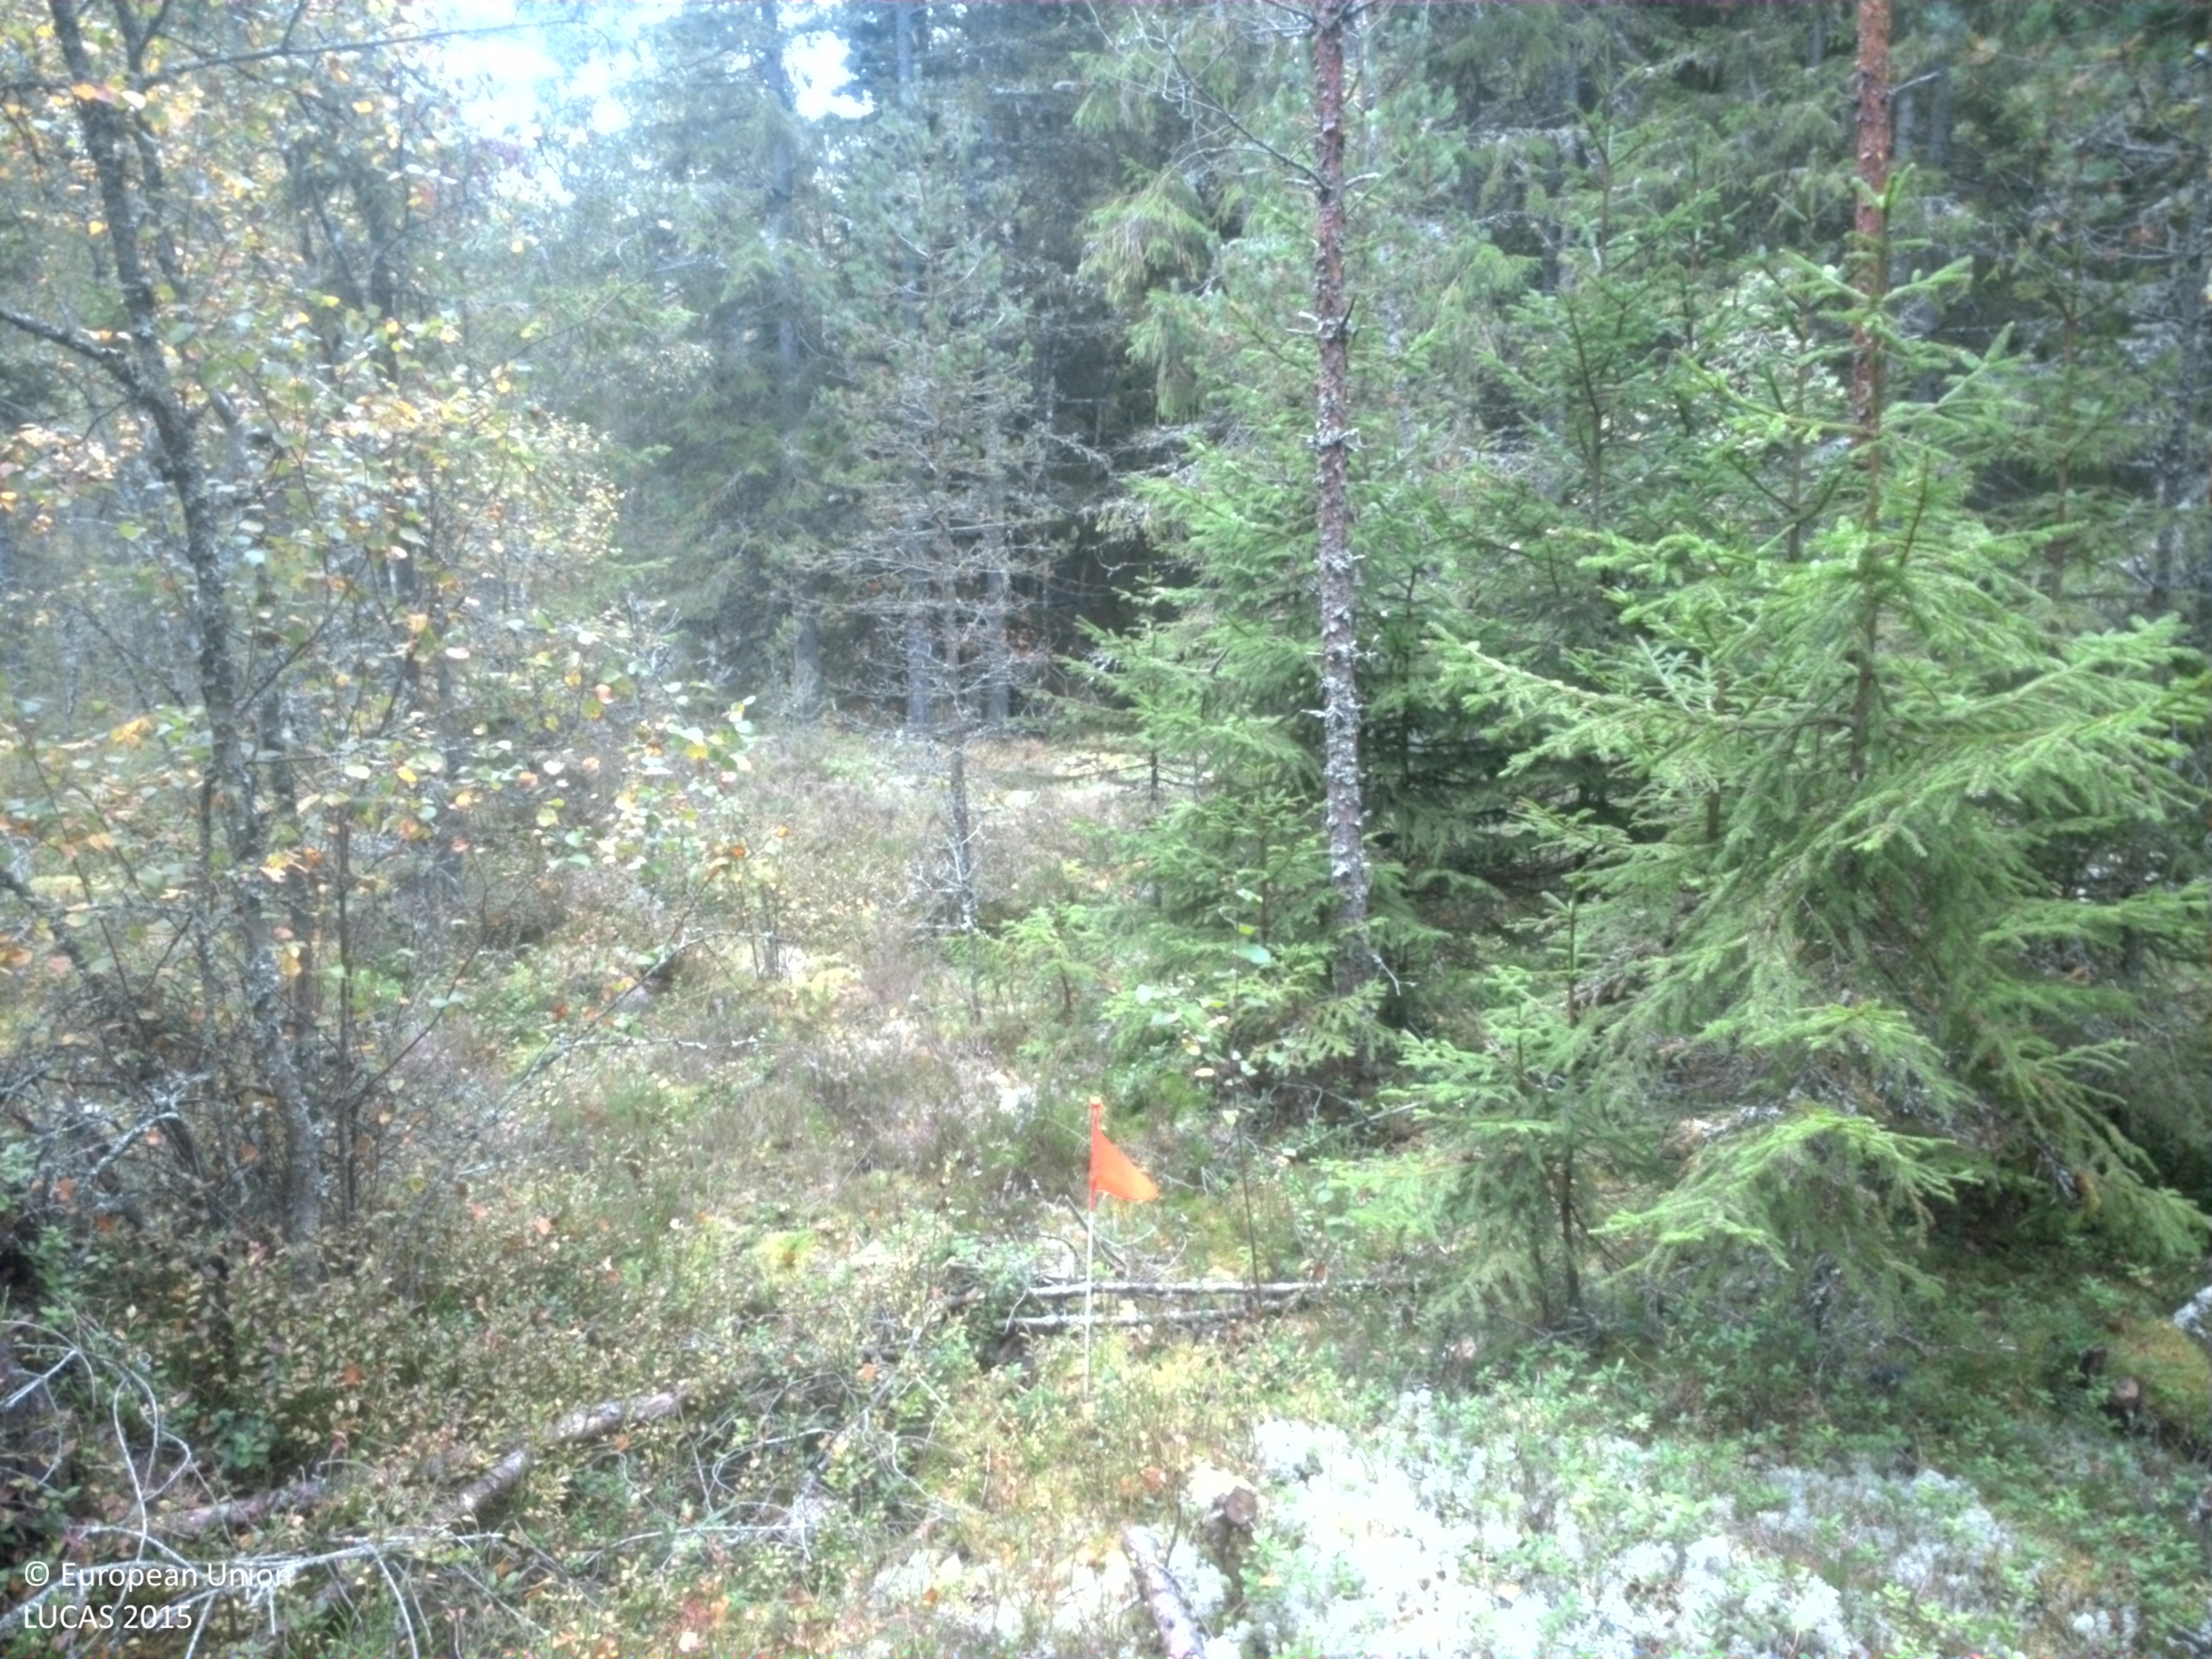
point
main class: Woodland
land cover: Pine dominated mixed woodland
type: boreal forest
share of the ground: > 75 %
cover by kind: coniferous forest trees 55 %, broadleaved forest trees 20 %, shrubs 15 %, lichens and mosses 5 %, consolidated bare surface 5 %
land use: Forestry
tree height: > 5 m
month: September
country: SE
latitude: 59.4042
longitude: 15.5400
